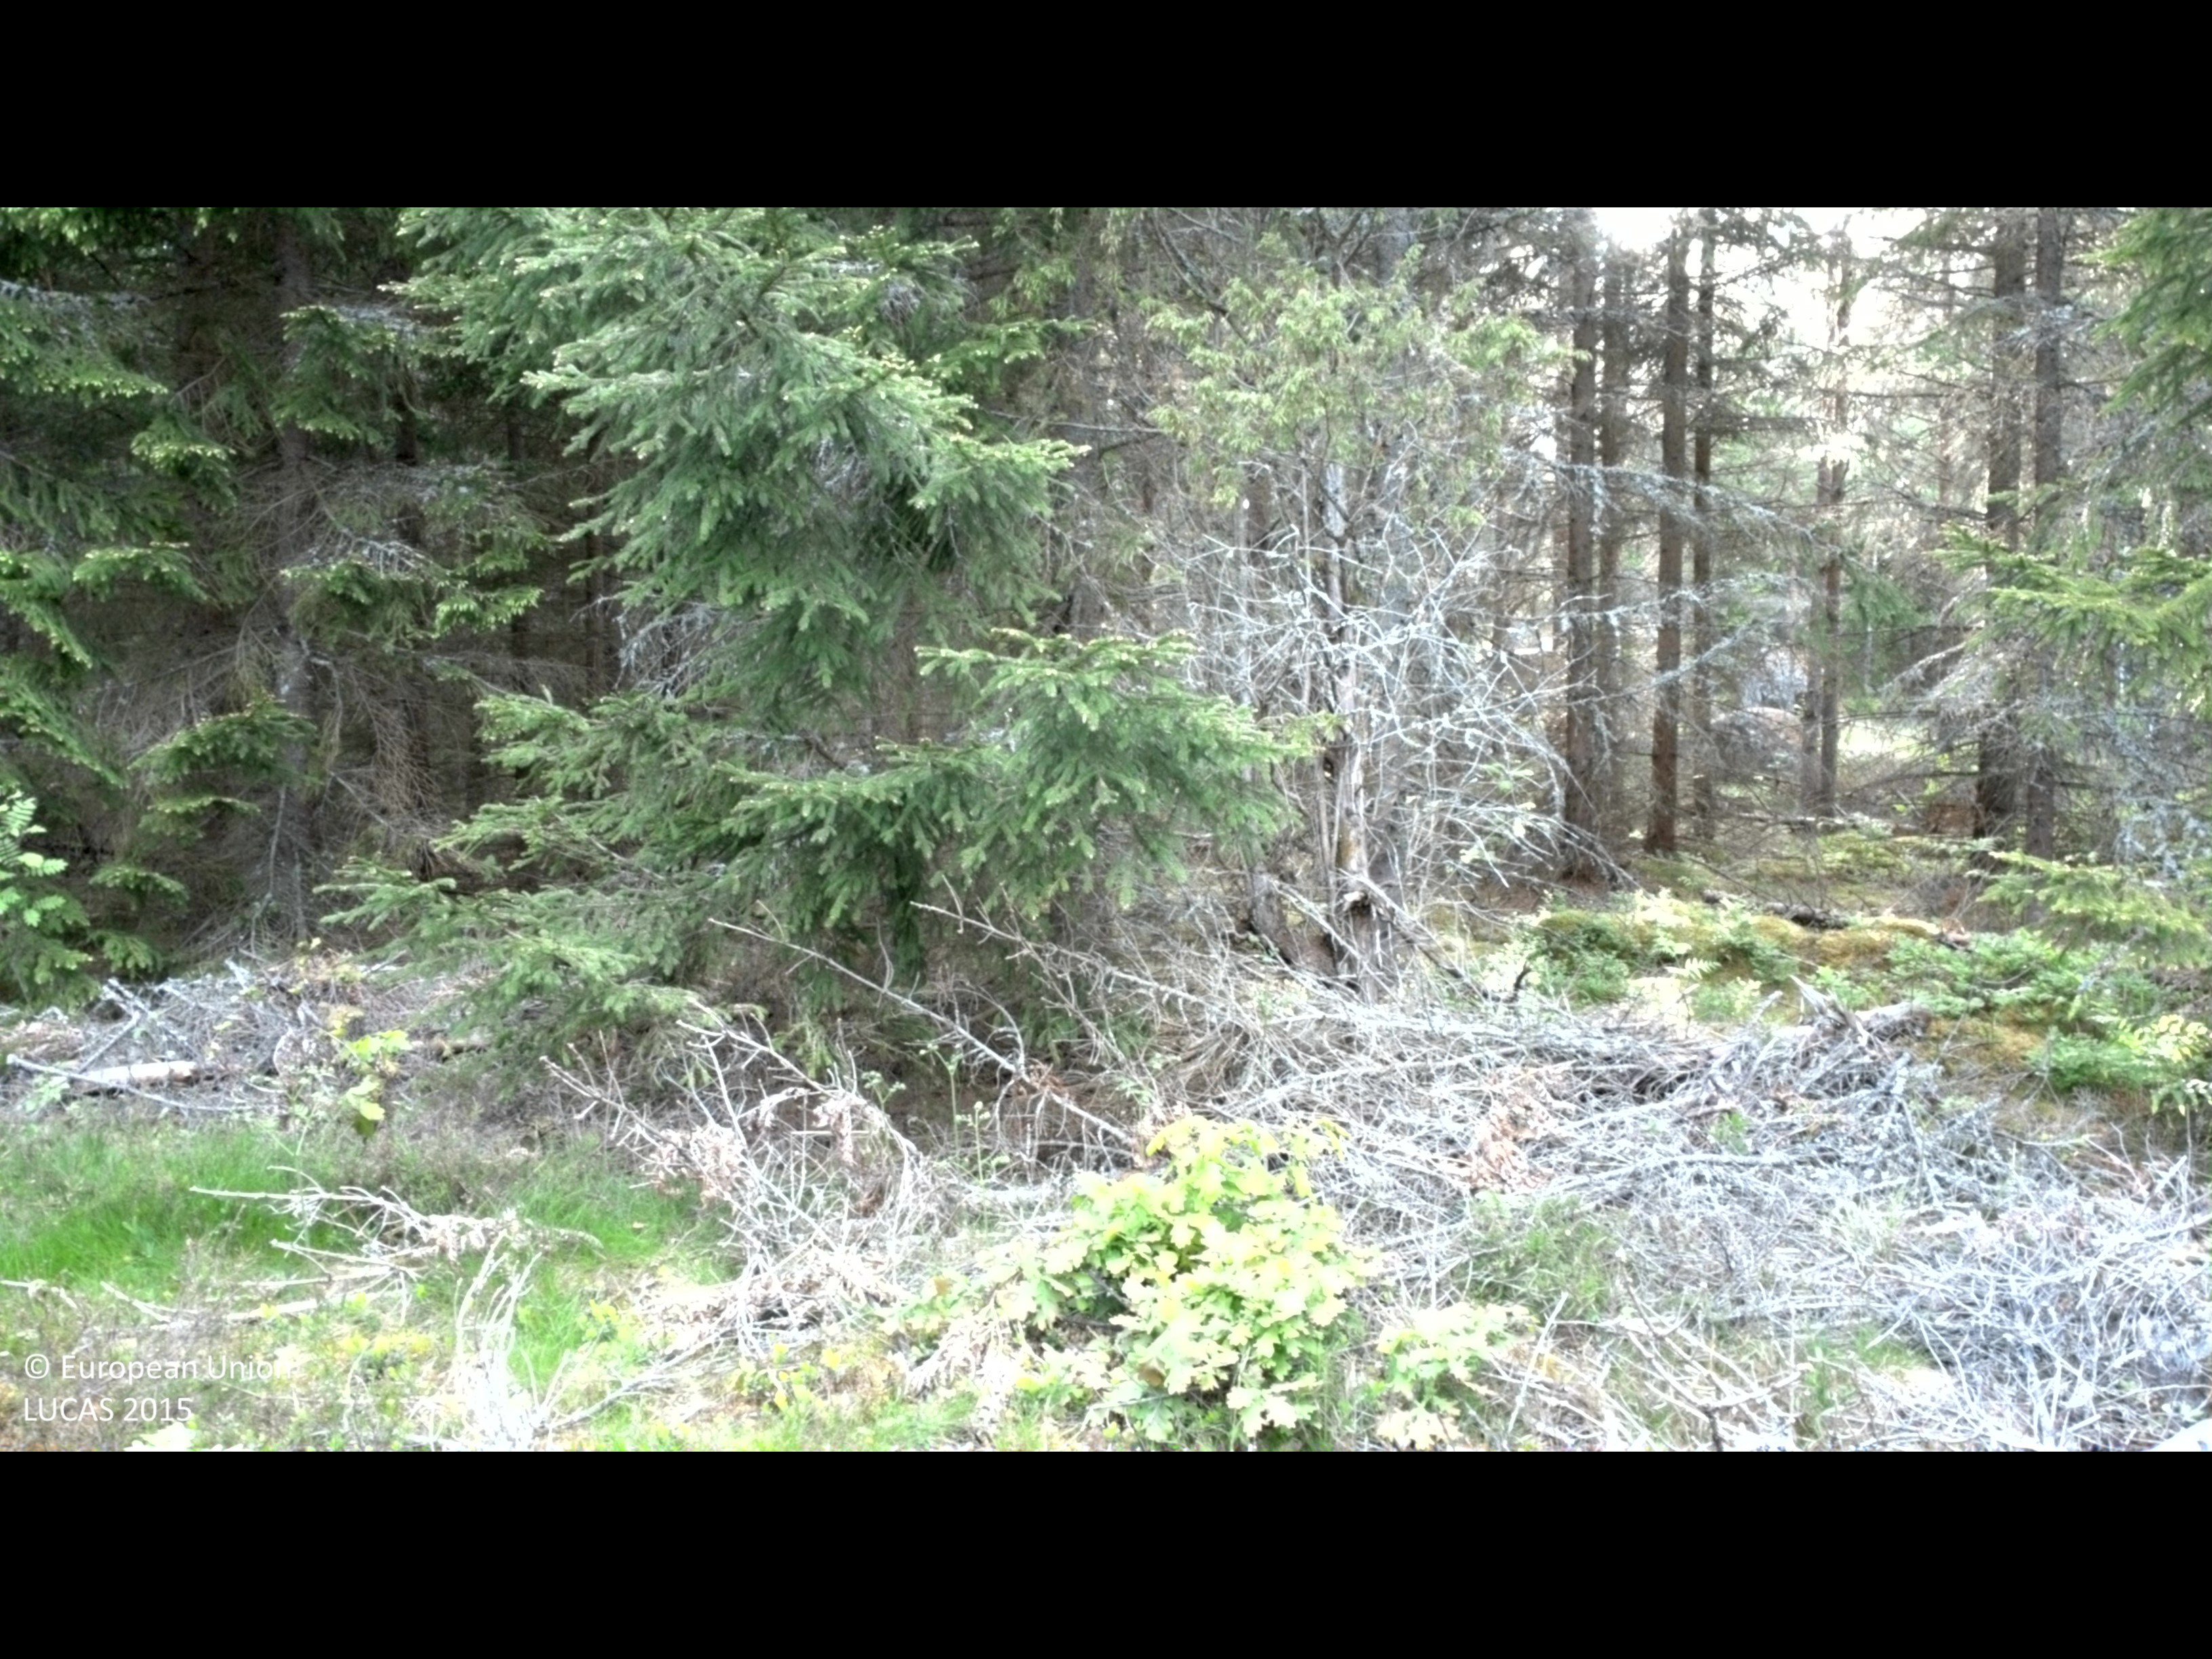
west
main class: Woodland
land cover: Spruce dominated coniferous woodland
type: boreal forest
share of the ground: 25 - 50 %
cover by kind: coniferous forest trees 40 %, shrubs 35 %, lichens and mosses 20 %, broadleaved forest trees 5 %
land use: Forestry
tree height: > 5 m
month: June
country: SE
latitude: 57.7860
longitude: 16.2375
